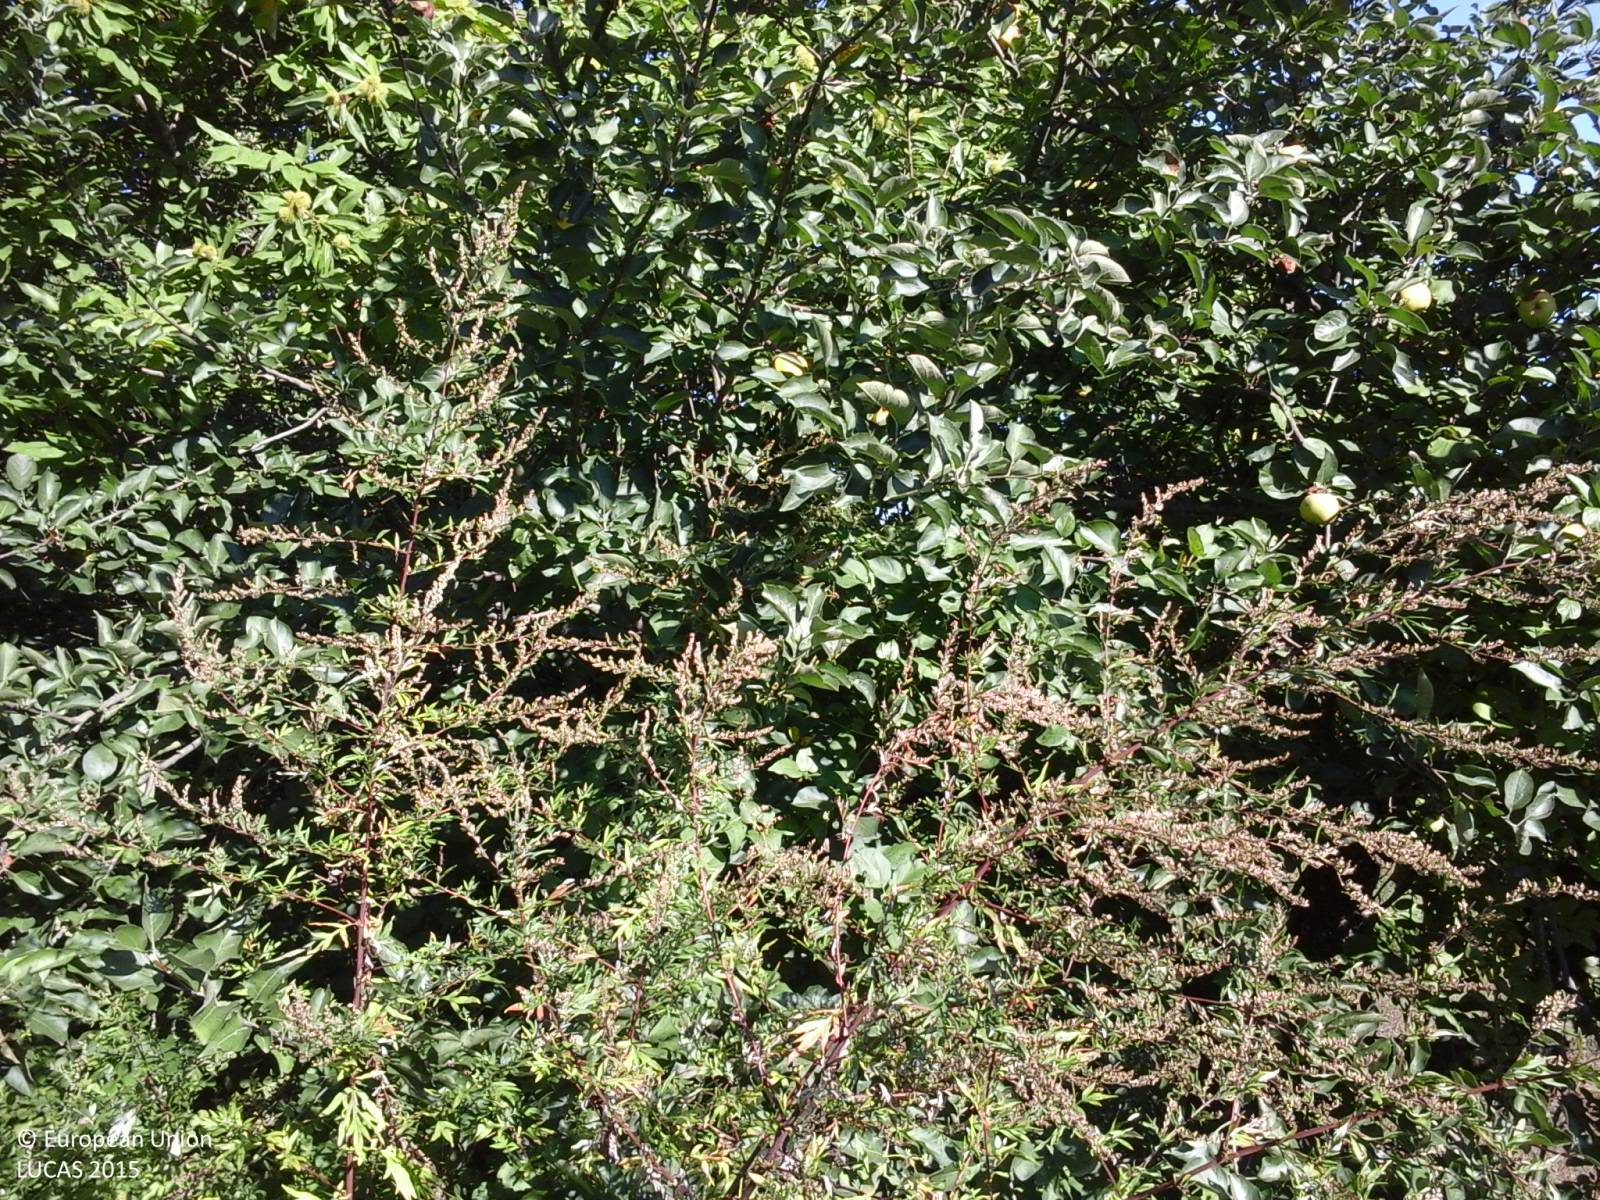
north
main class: Woodland
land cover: Broadleaved woodland
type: thermophilous deciduous forest
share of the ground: > 75 %
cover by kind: broadleaved forest trees 90 %, shrubs 10 %
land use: Forestry
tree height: > 5 m
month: September
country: IT
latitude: 42.7235
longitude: 12.0572
